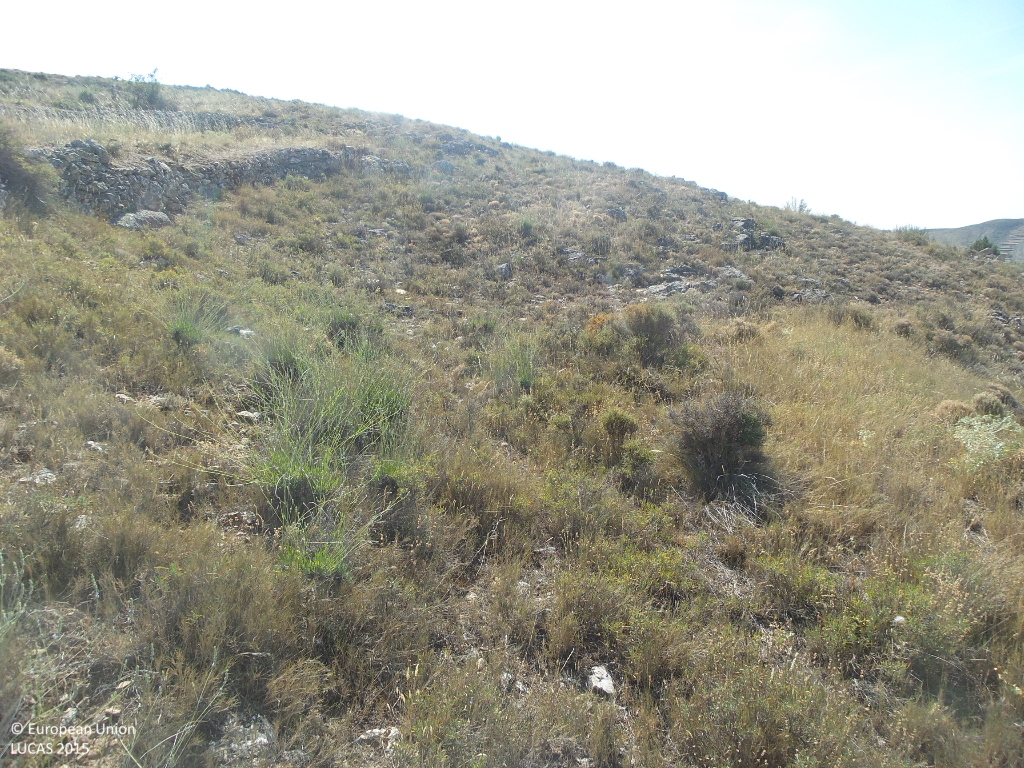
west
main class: Shrubland
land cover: Shrubland without tree cover
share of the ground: 50 - 75 %
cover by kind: shrubs 70 %, unconsolidated bare surface 25 %, herbaceous plants 5 %
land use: Semi-natural and natural areas not in use
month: July
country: ES
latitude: 41.2621
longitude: -1.8548
